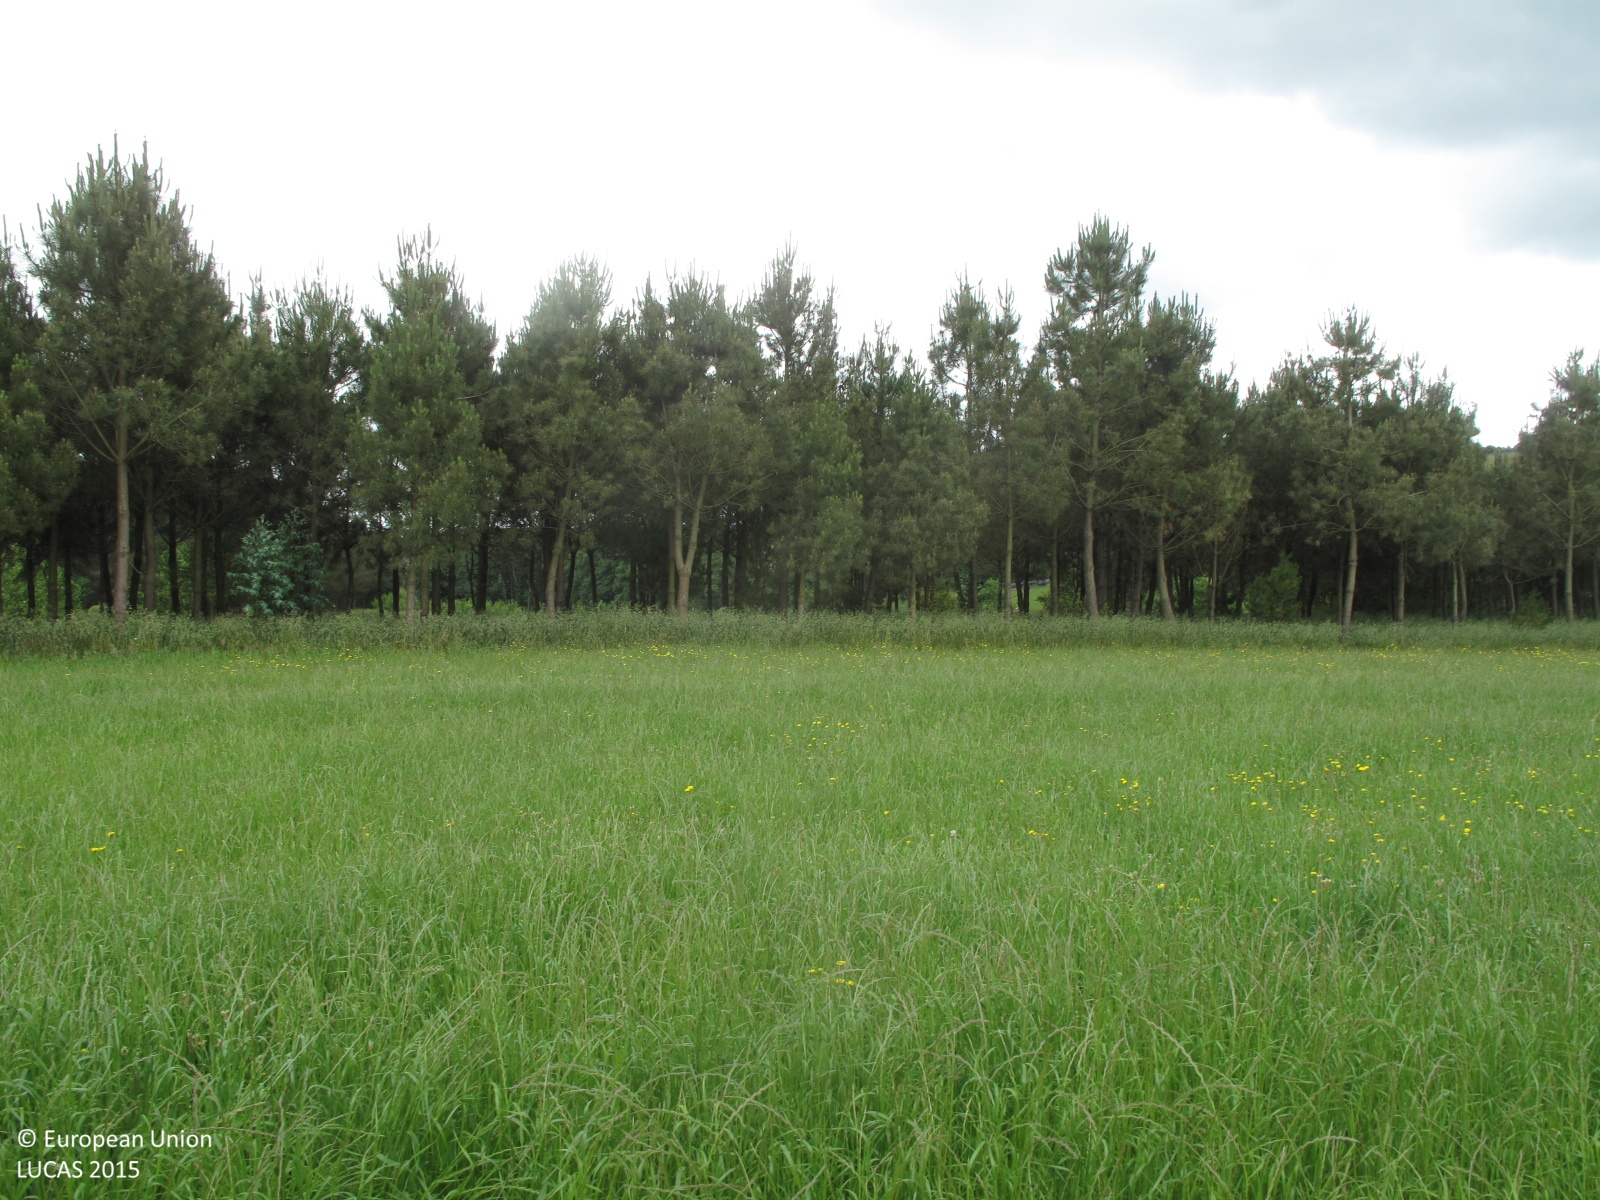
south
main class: Grassland
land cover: Grassland without tree/shrub cover
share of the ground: > 75 %
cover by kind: herbaceous plants 100 %
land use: Agriculture (excluding fallow land and kitchen gardens)
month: June
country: ES
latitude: 43.0592
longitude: -8.5878
